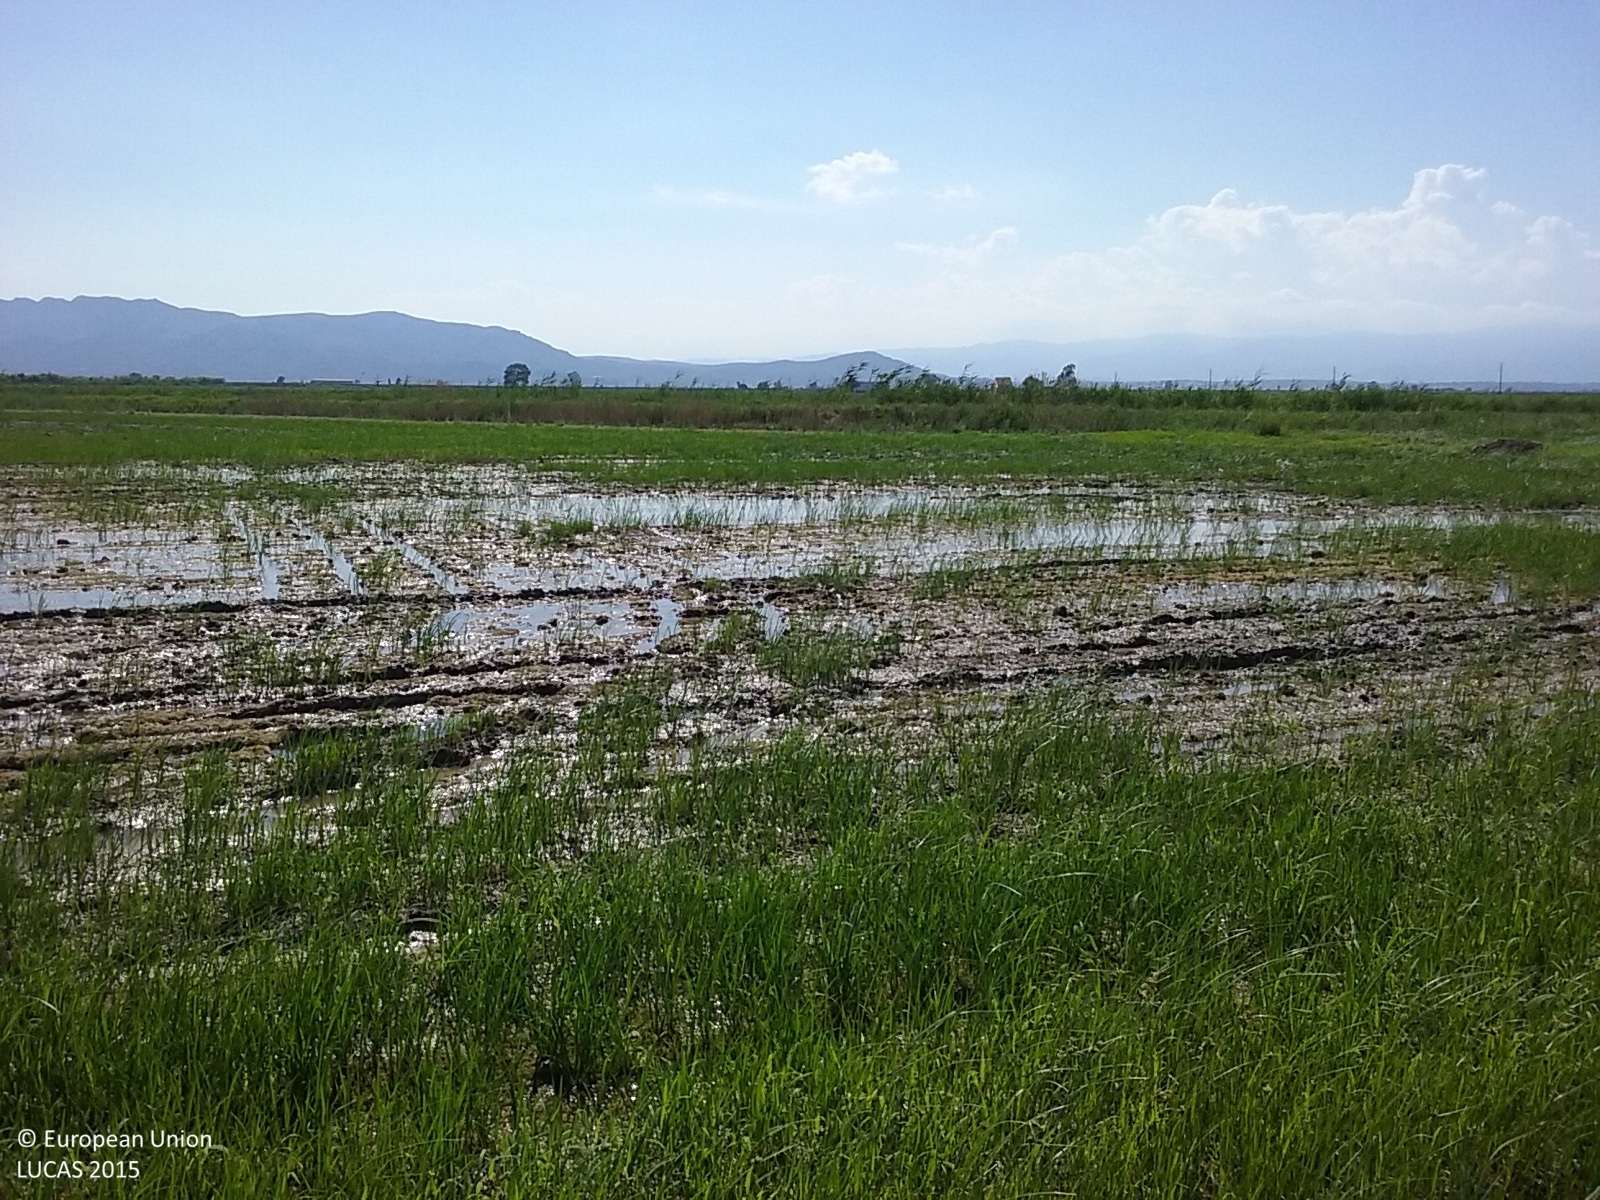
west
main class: Cropland
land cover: Rice
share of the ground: 50 - 75 %
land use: Agriculture (excluding fallow land and kitchen gardens)
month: June
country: ES
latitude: 40.6785
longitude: 0.6845
